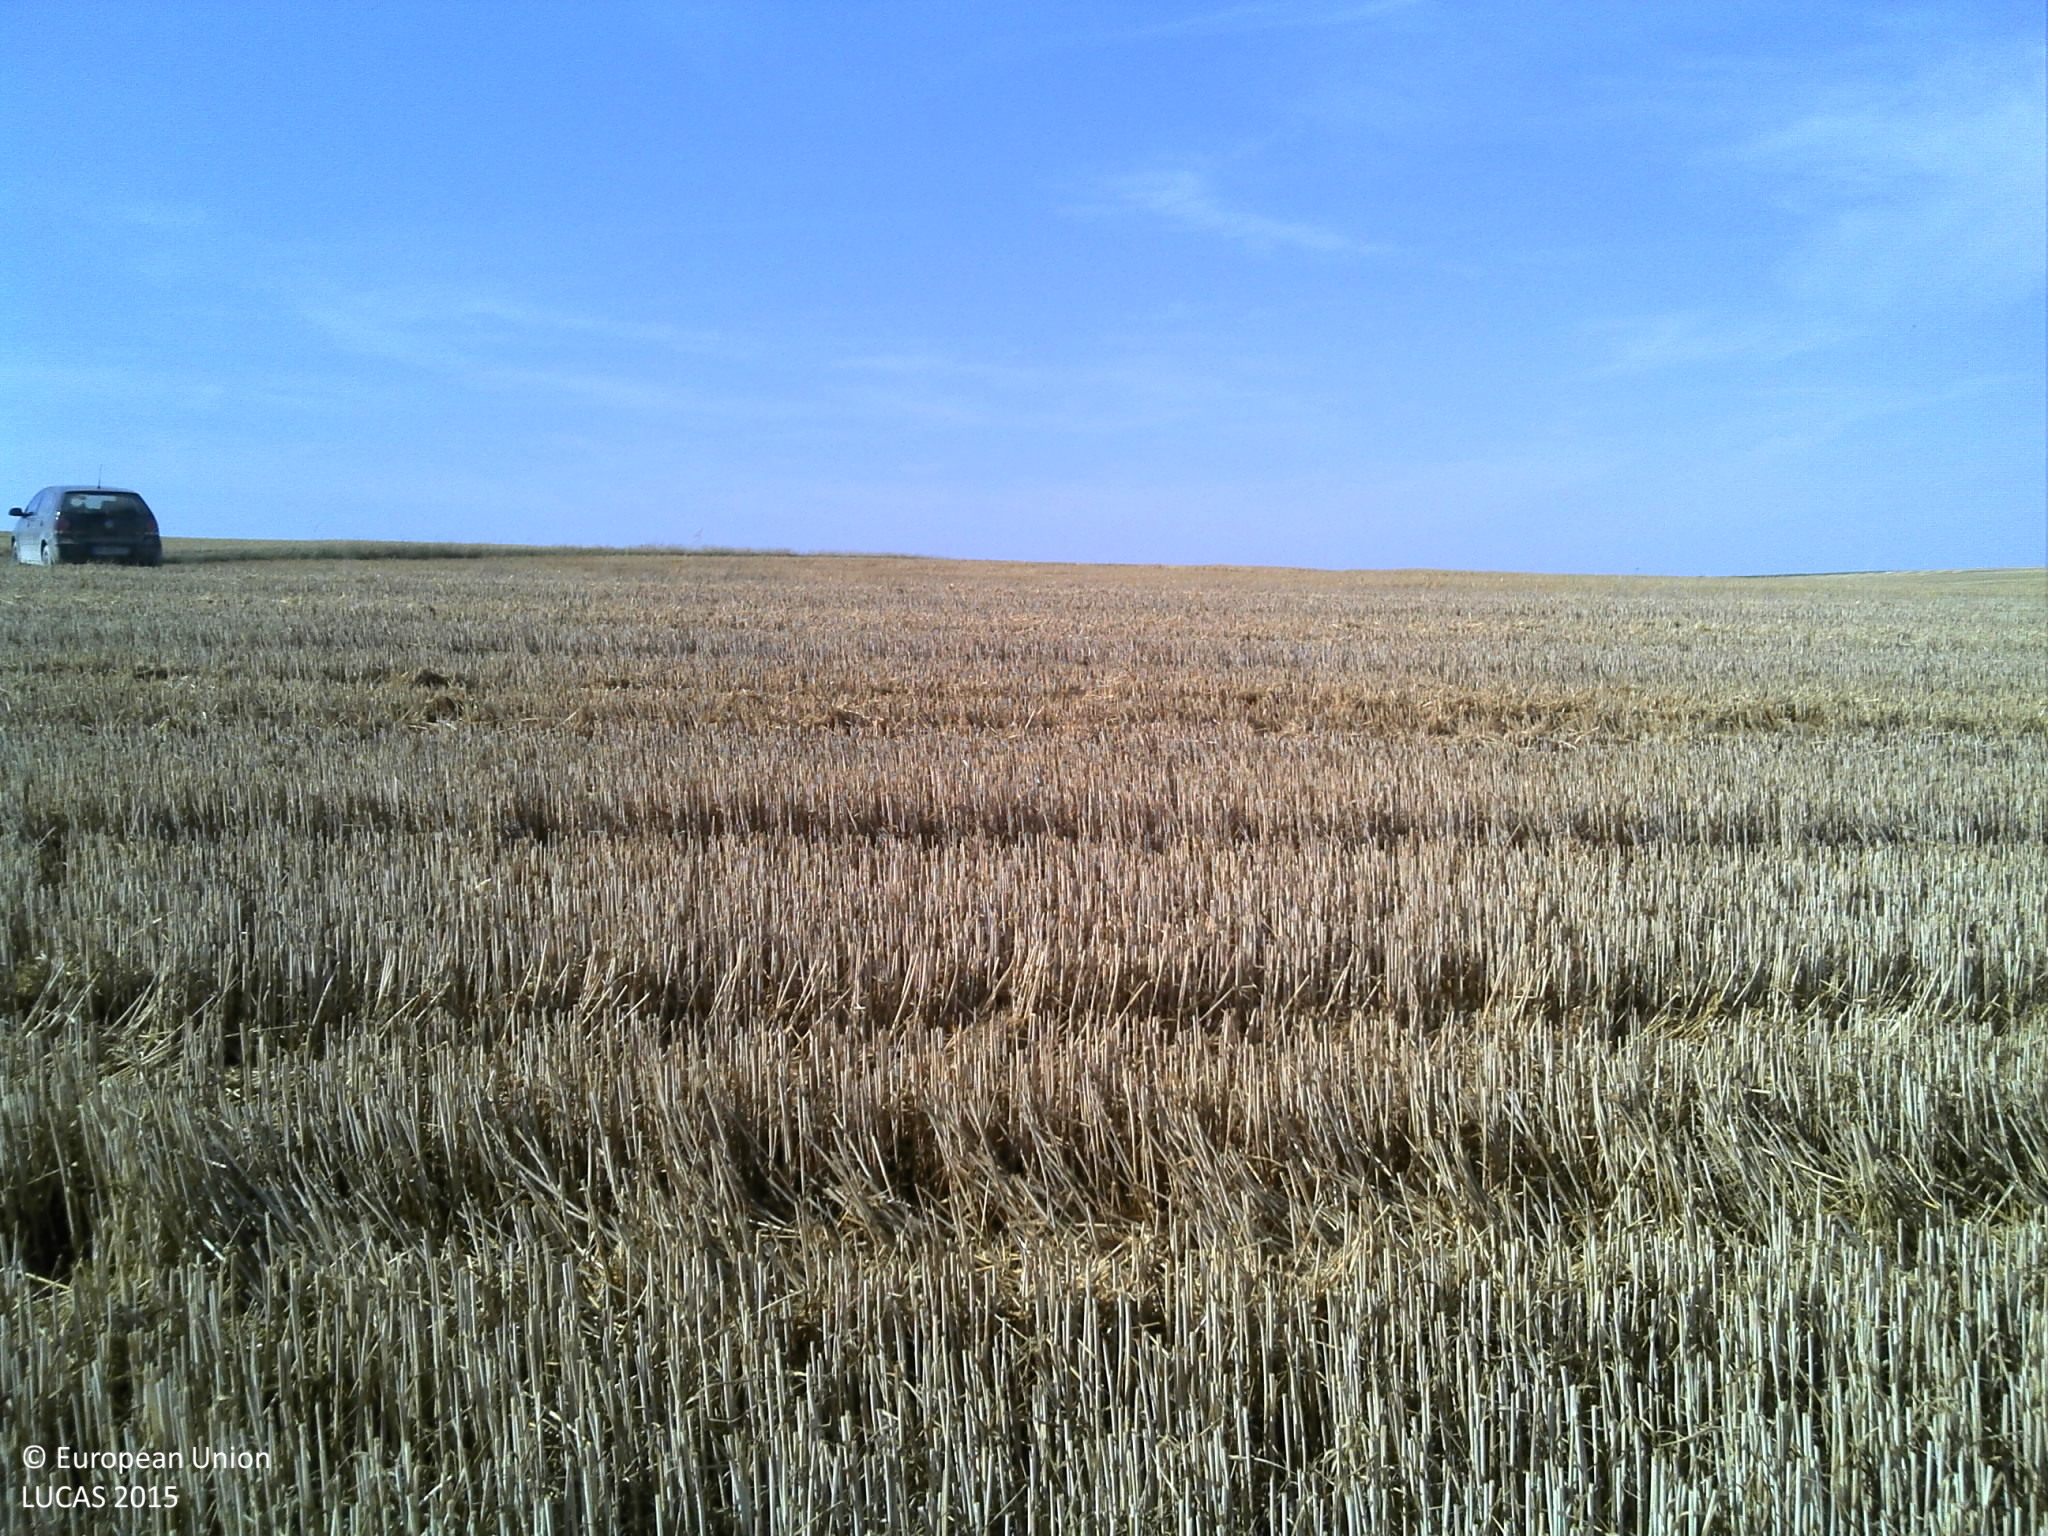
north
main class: Cropland
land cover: Common wheat
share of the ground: > 75 %
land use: Agriculture (excluding fallow land and kitchen gardens)
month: August
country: FR
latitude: 49.1069
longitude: 4.7233
